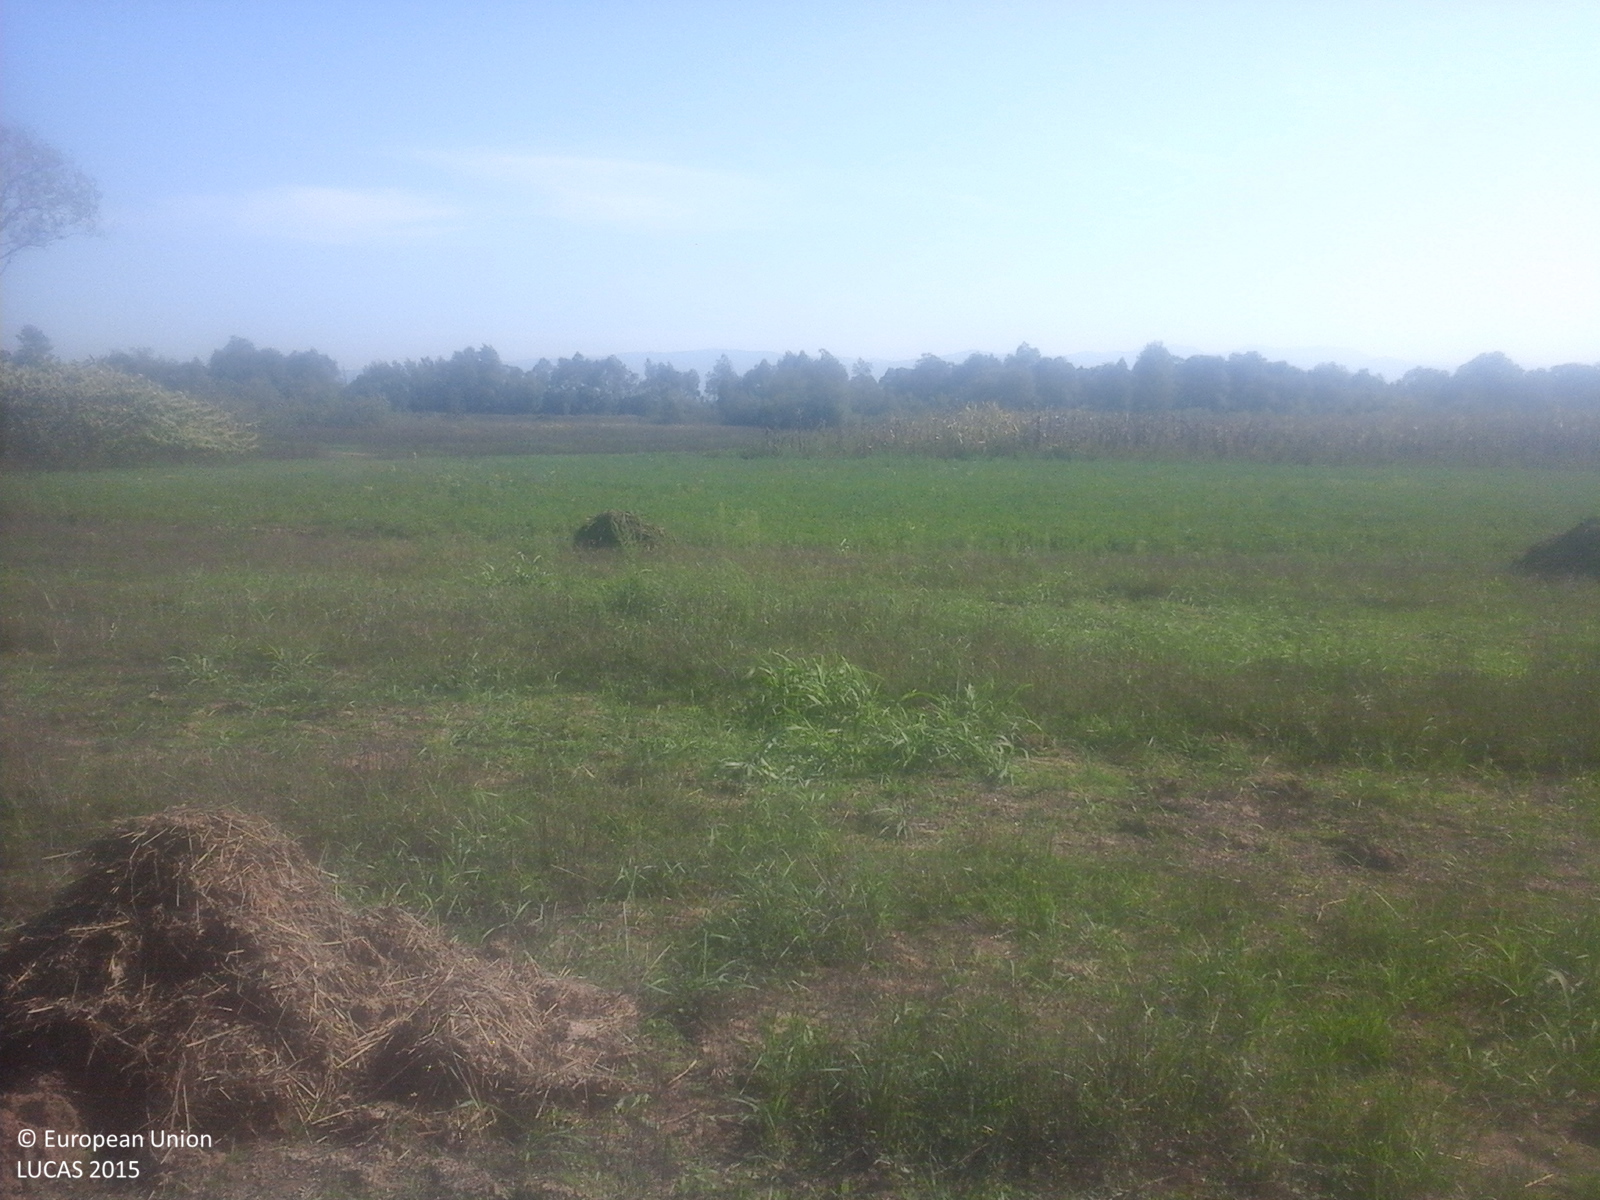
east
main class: Cropland
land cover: Lucerne
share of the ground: > 75 %
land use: Agriculture (excluding fallow land and kitchen gardens)
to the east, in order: Lucerne; Other leguminous and mixtures for fodder; Lucerne; Maize; Spontaneously vegetated surfaces; Tracks; Spontaneously vegetated surfaces
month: September
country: RO
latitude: 46.6793
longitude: 22.2726
